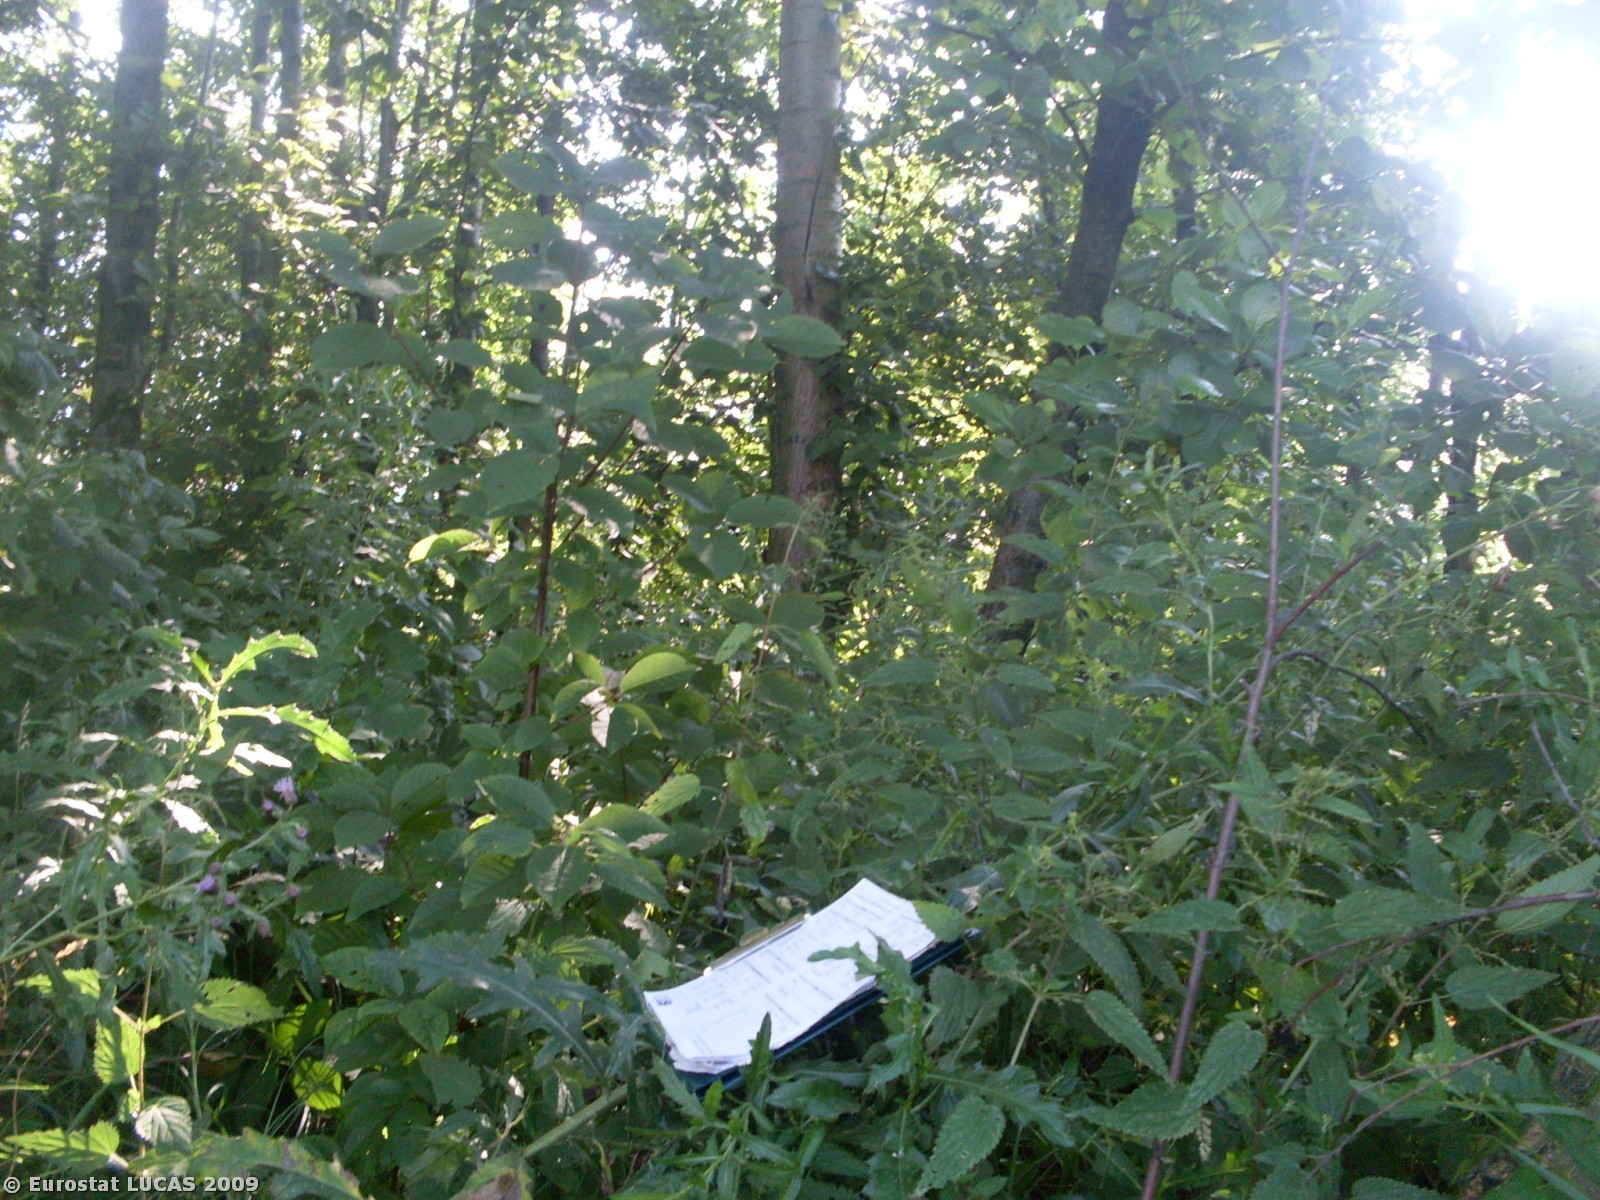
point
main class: Woodland
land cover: Broadleaved woodland
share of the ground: > 75 %
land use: Unused
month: August
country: PL
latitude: 49.9871
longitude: 20.5122
